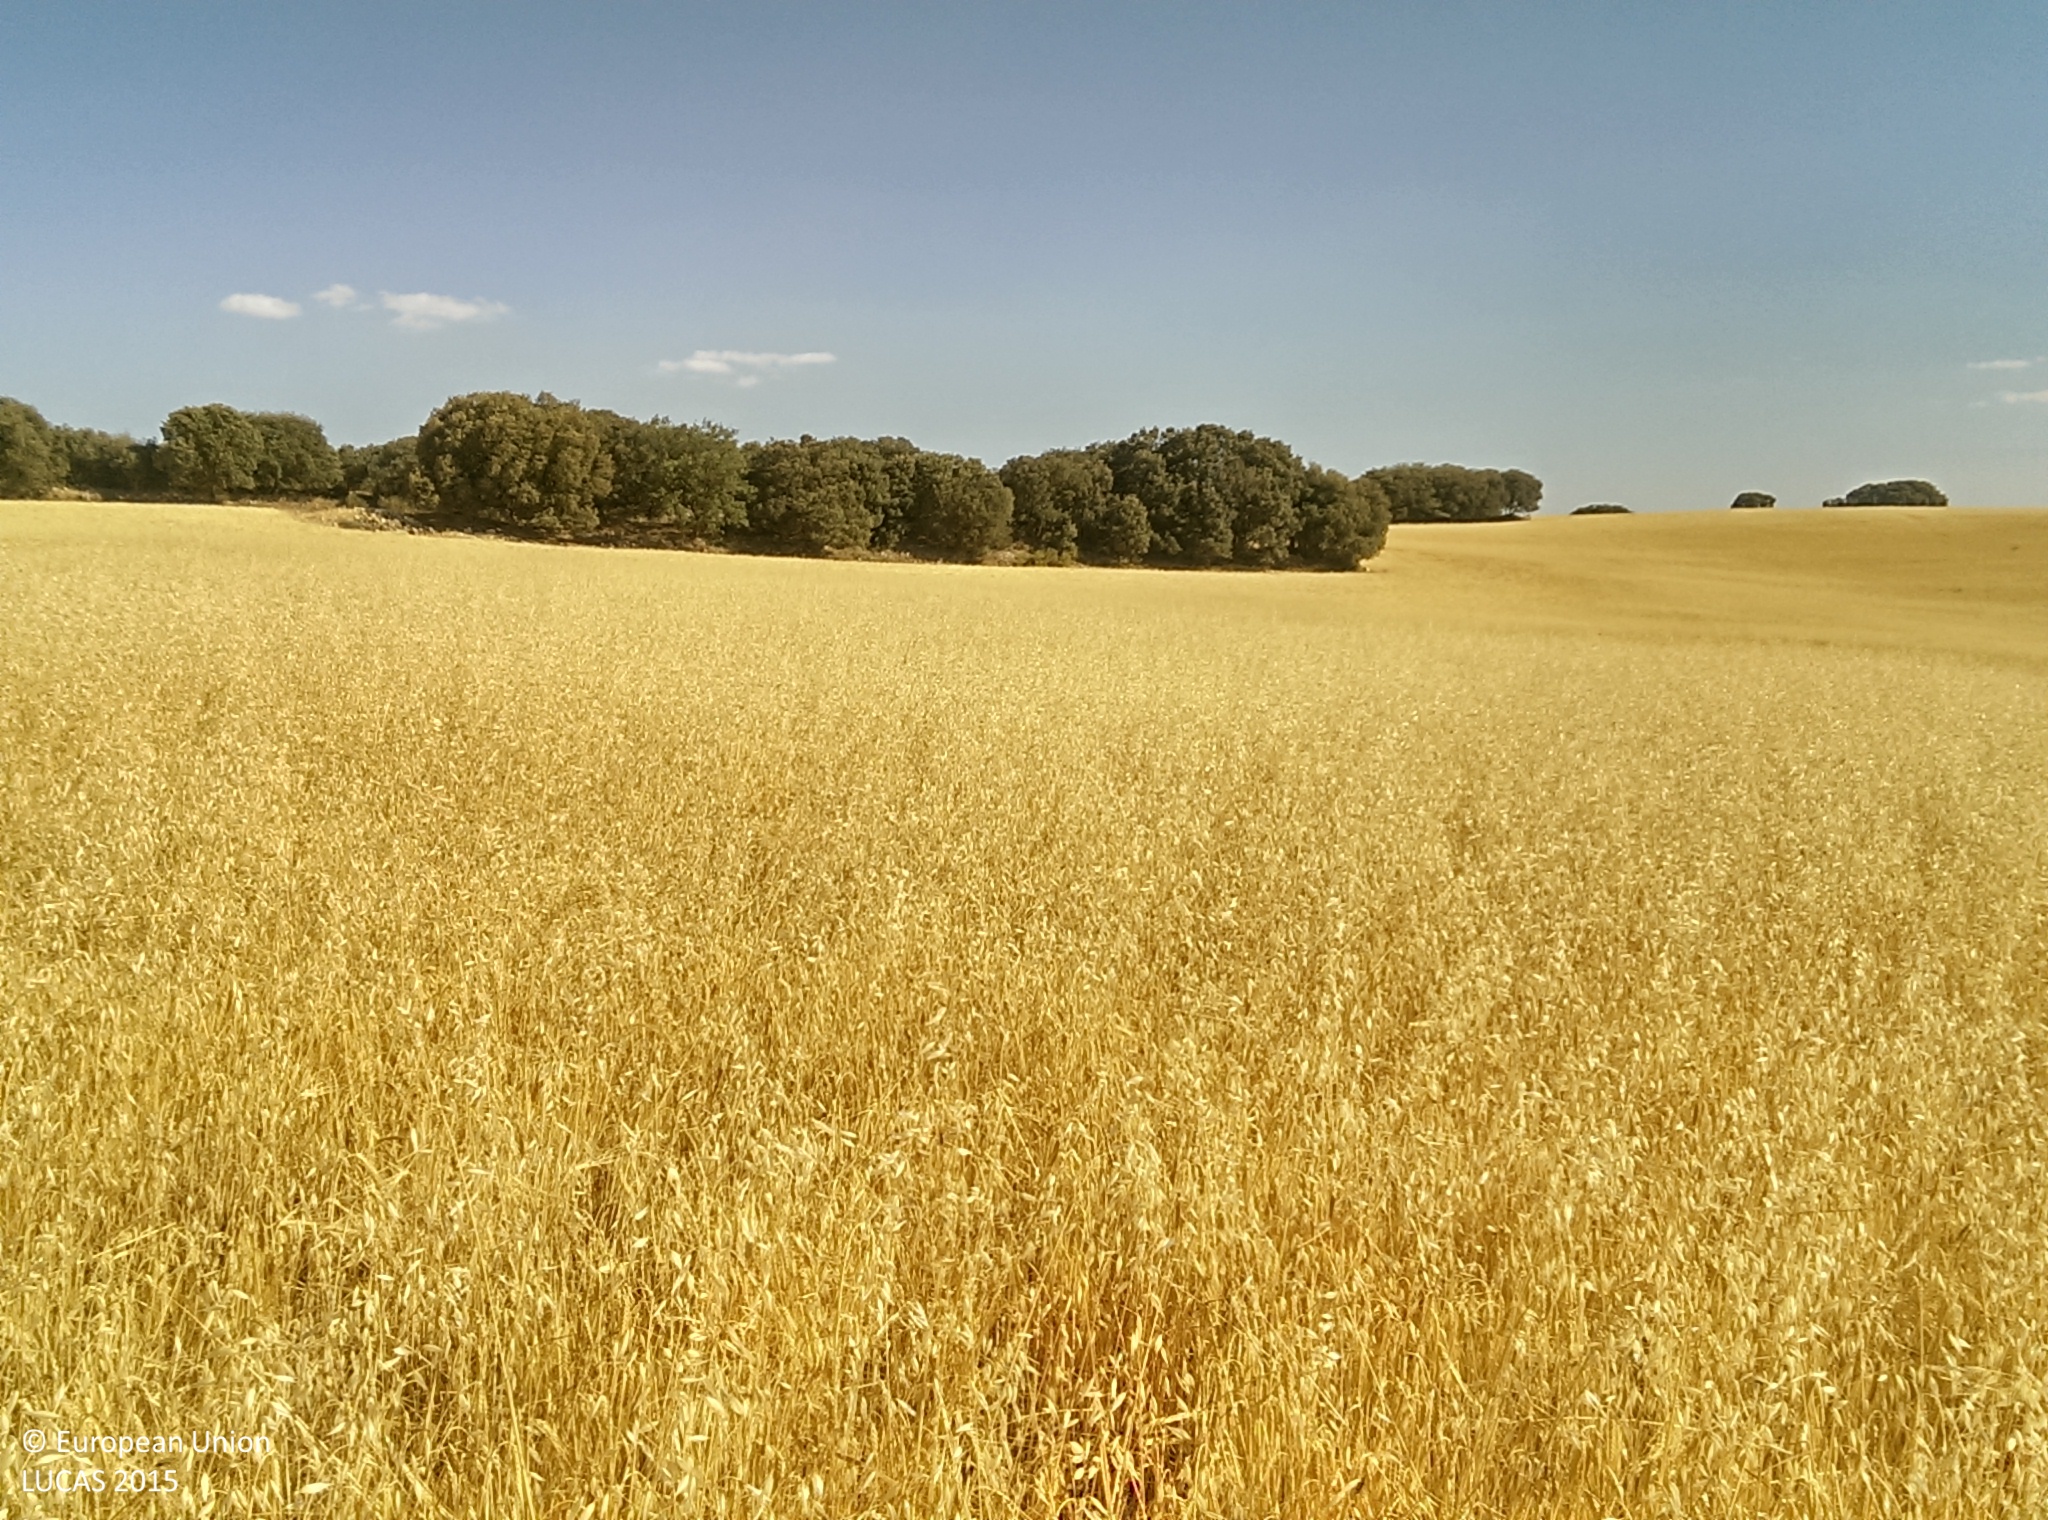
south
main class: Cropland
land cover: Barley
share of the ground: > 75 %
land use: Agriculture (excluding fallow land and kitchen gardens)
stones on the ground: < 10 %
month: June
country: ES
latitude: 37.5441
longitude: -3.2911
